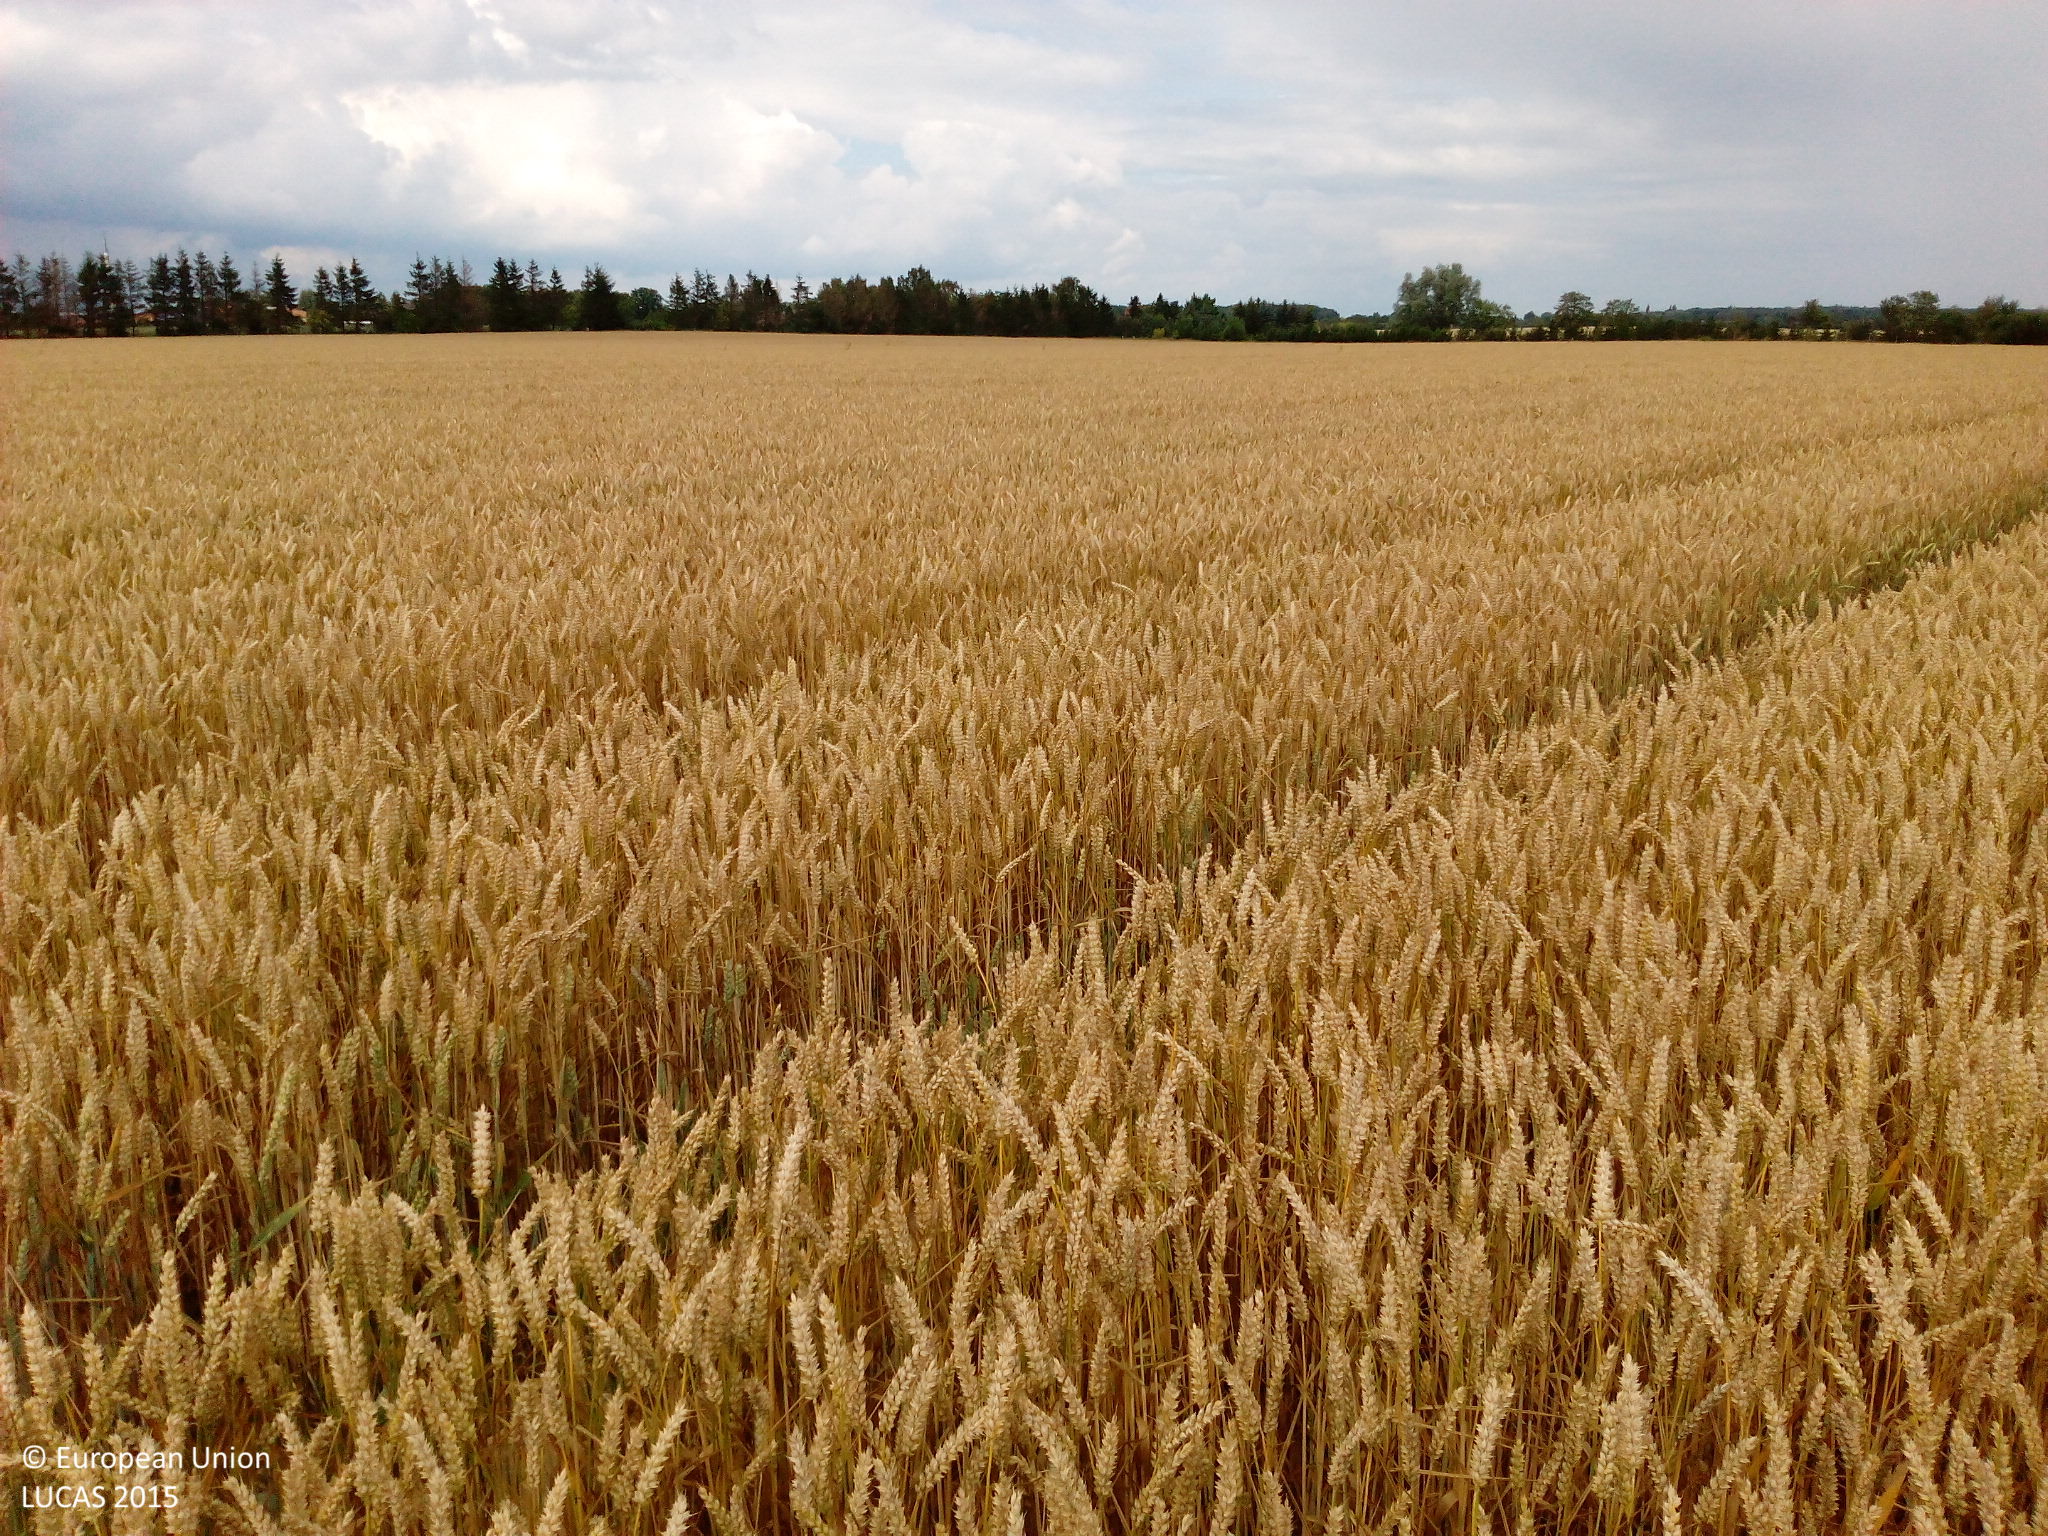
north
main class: Cropland
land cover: Common wheat
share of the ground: > 75 %
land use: Agriculture (excluding fallow land and kitchen gardens)
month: July
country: DE
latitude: 54.2720
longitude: 12.6556
